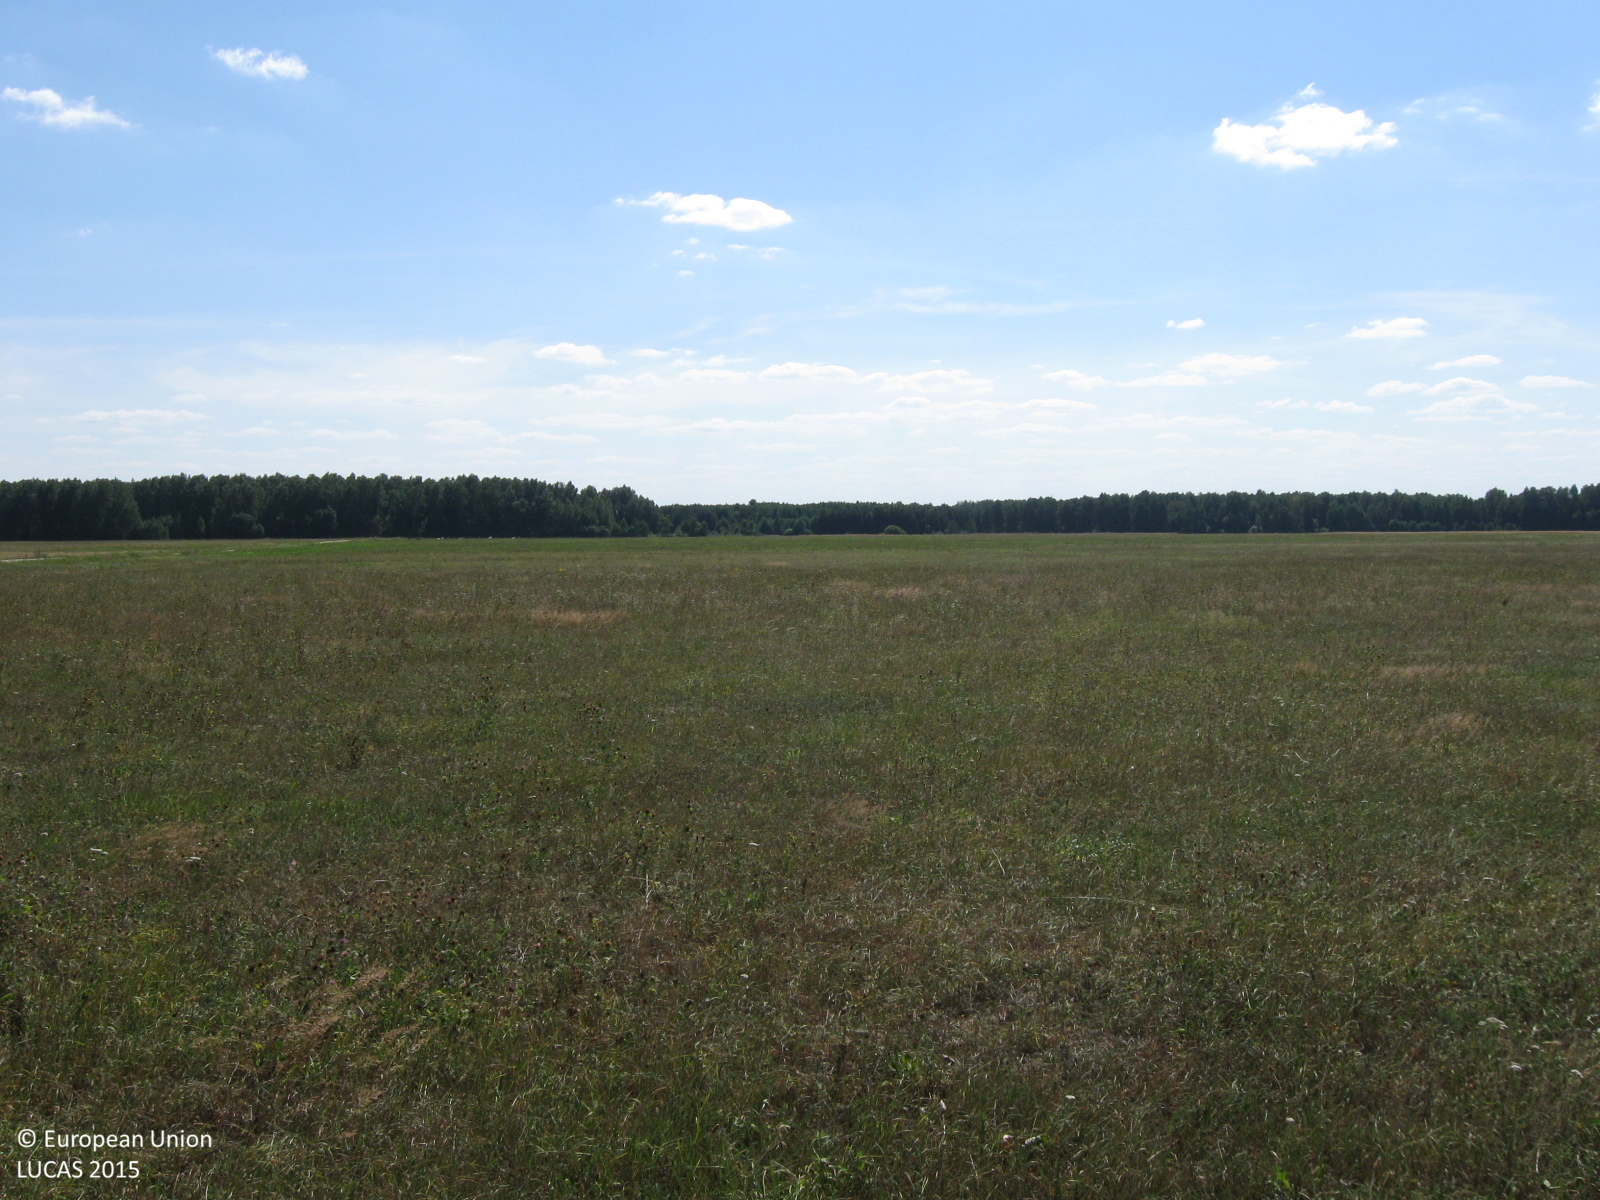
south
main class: Grassland
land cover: Grassland without tree/shrub cover
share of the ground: > 75 %
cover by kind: herbaceous plants 100 %
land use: Agriculture (excluding fallow land and kitchen gardens)
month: August
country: LT
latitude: 55.3367
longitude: 22.5005
